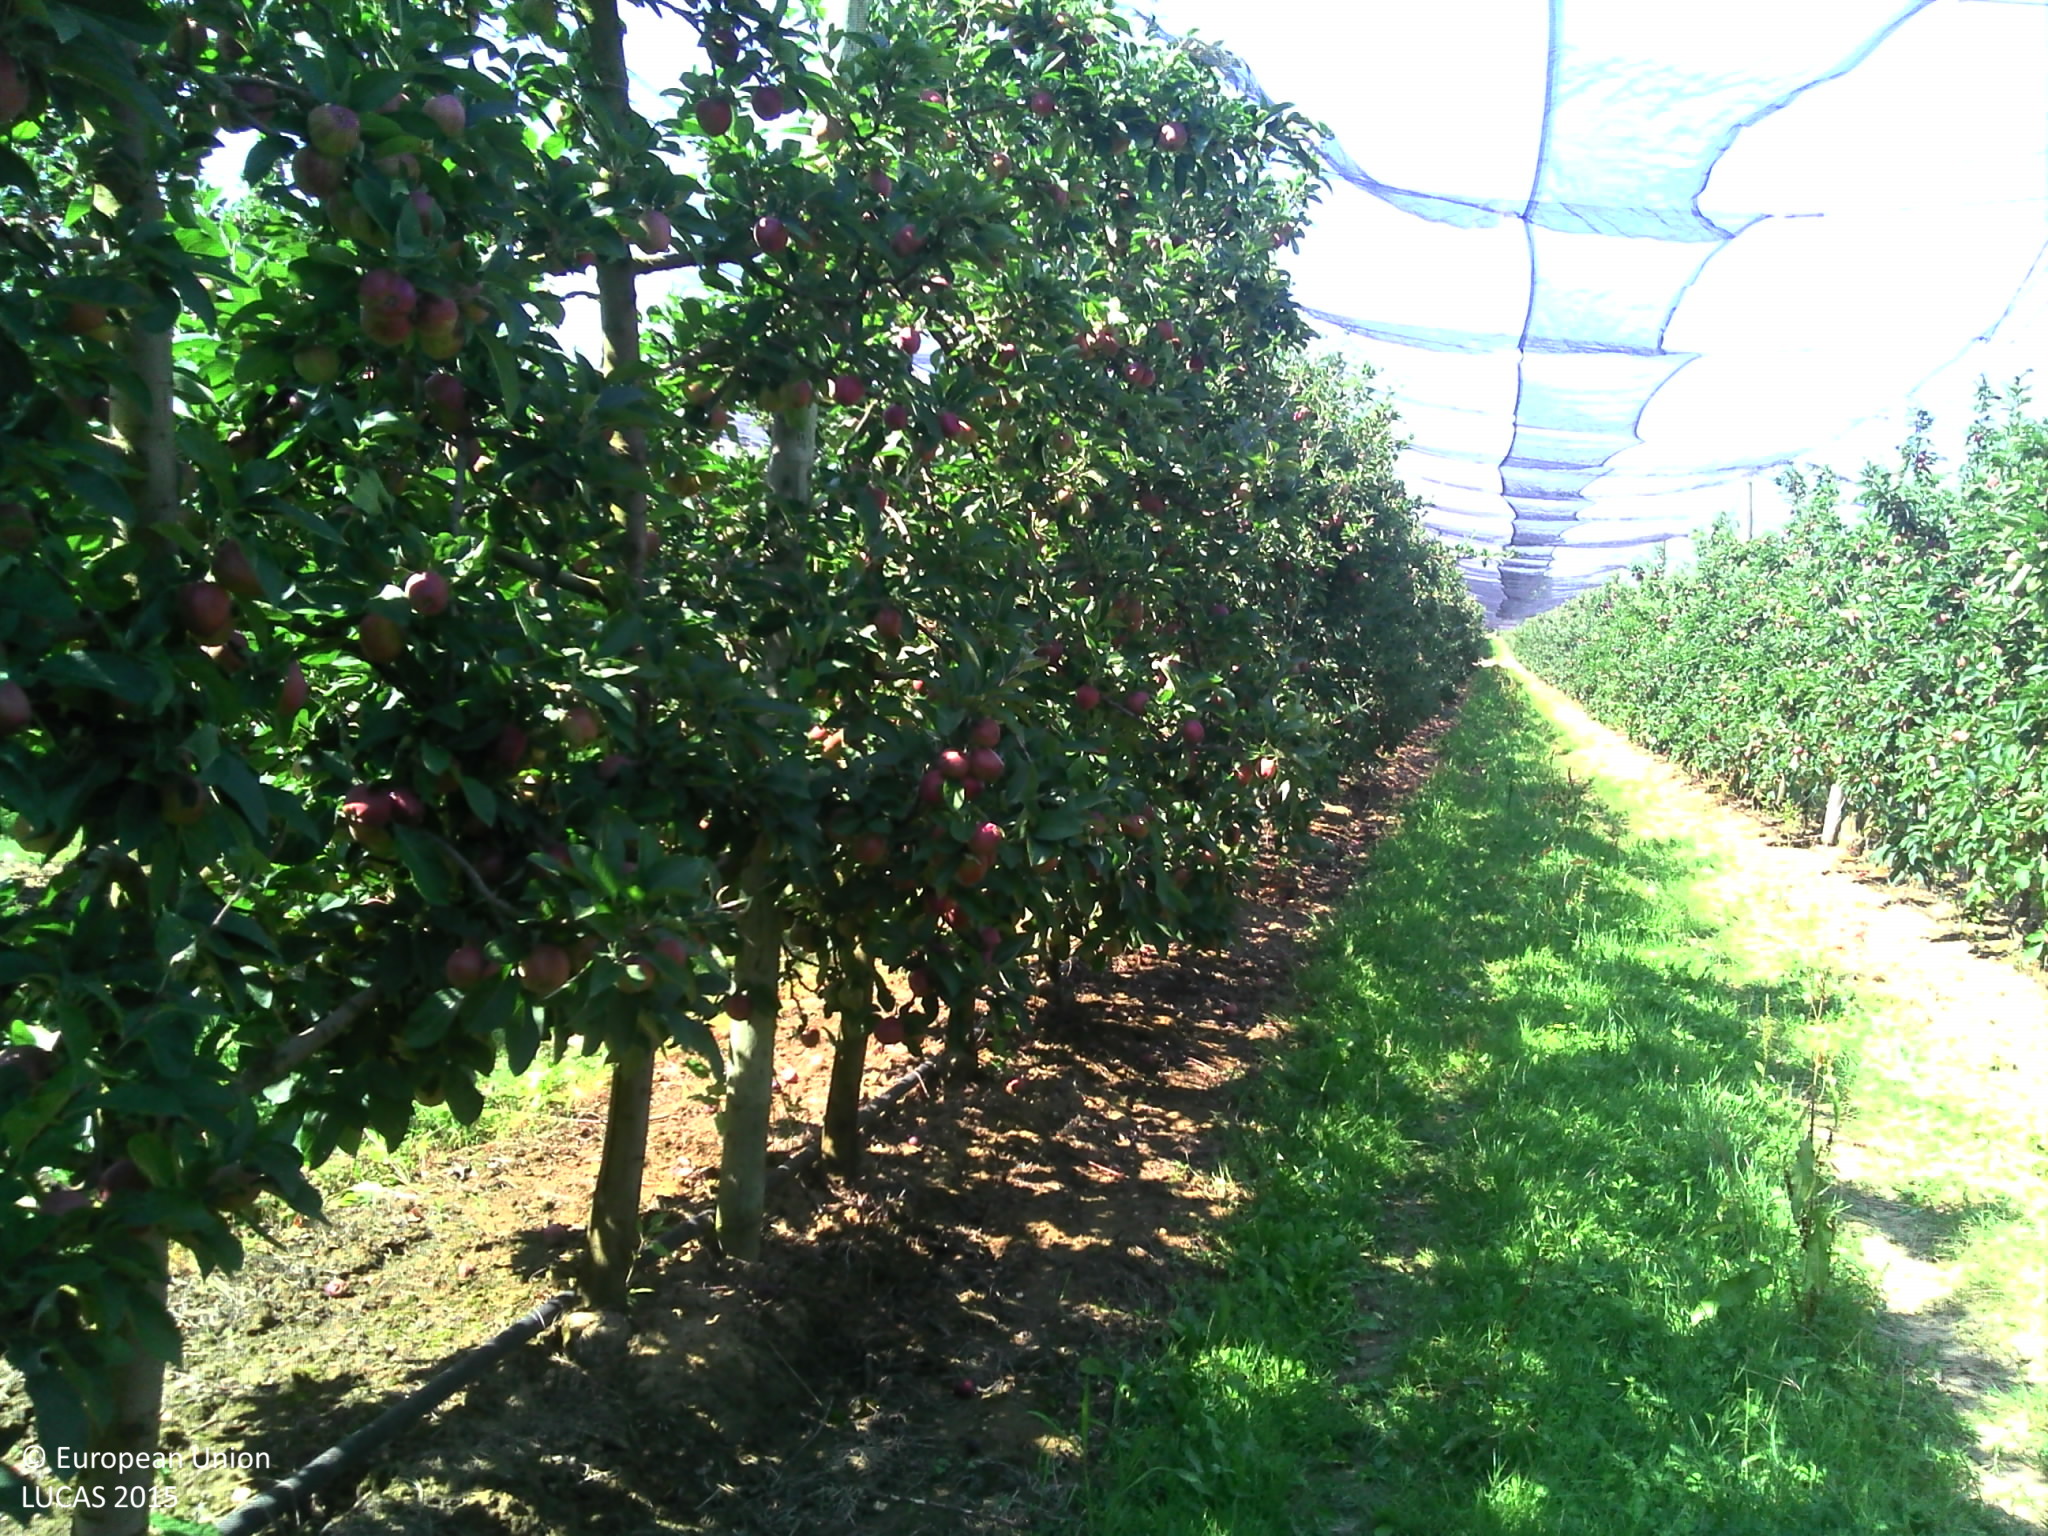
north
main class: Cropland
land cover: Apple fruit
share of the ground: 25 - 50 %
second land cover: Grassland without tree/shrub cover
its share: 25 - 50 %
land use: Agriculture (excluding fallow land and kitchen gardens)
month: July
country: FR
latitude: 44.0472
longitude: 0.9741
